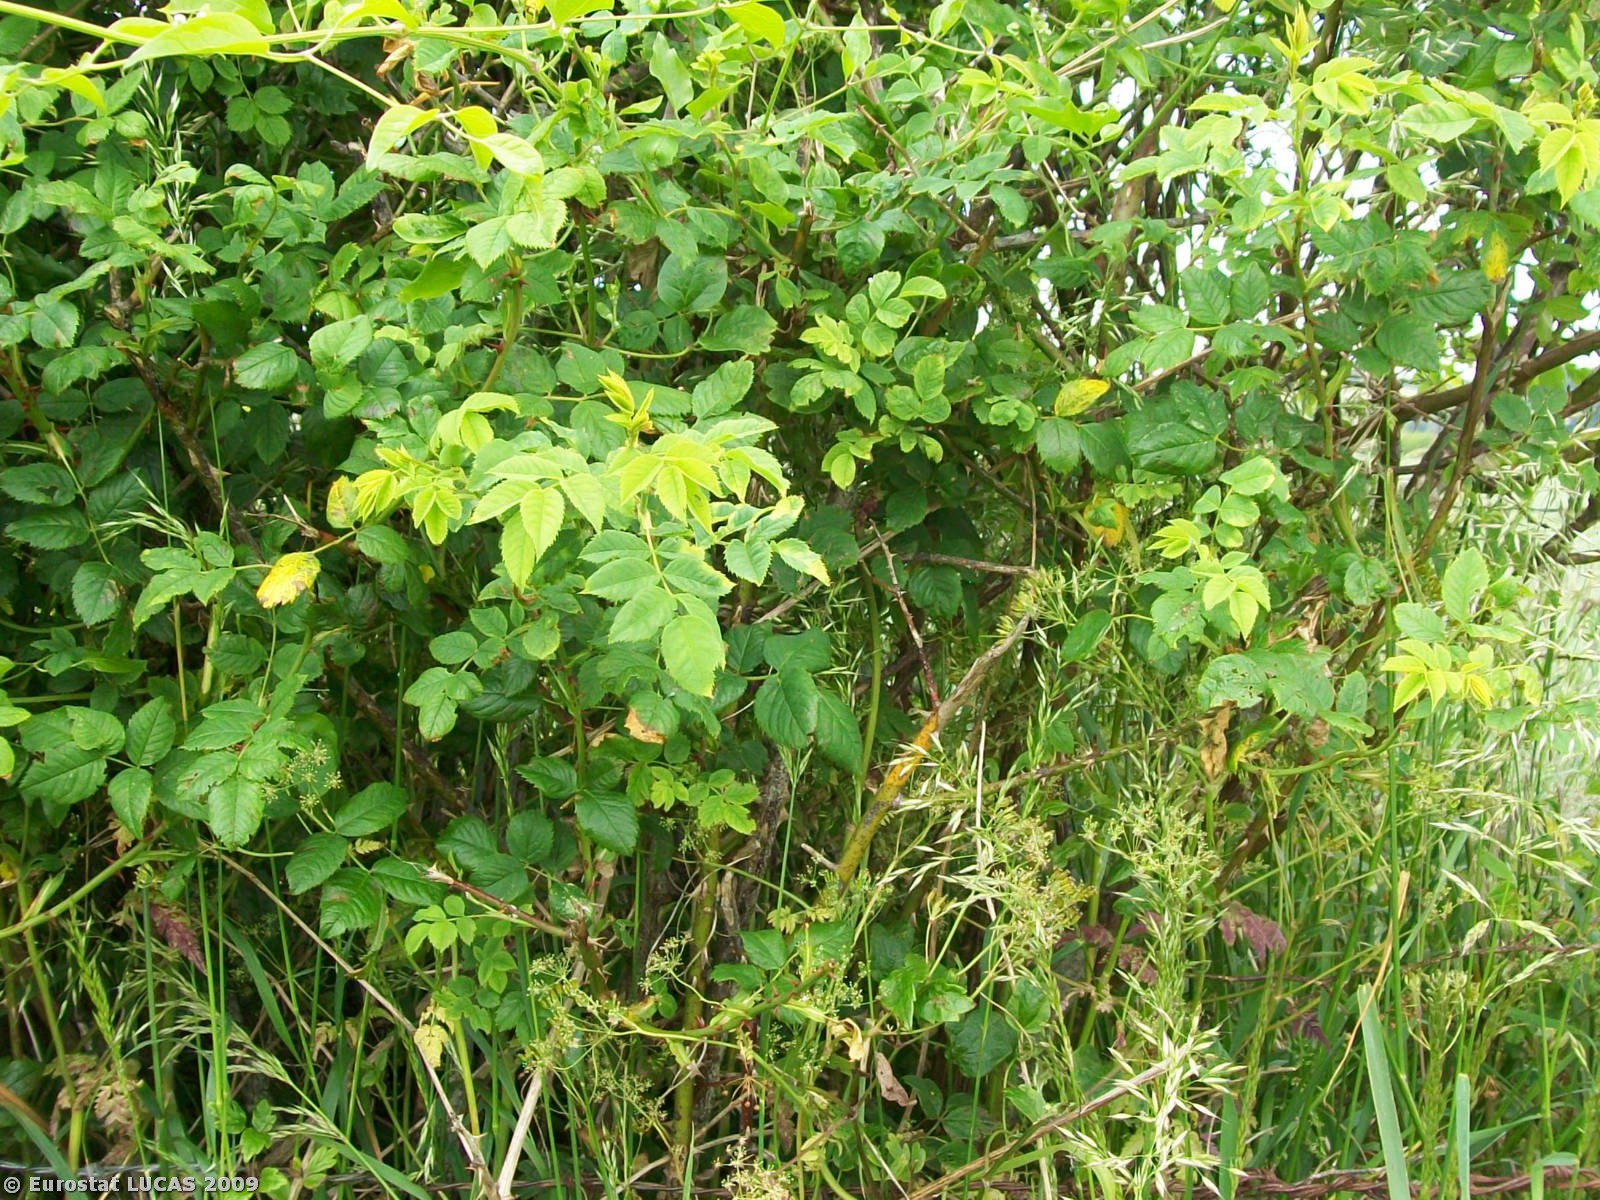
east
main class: Cropland
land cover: Barley
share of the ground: > 75 %
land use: Agriculture (excluding fallow land and kitchen gardens)
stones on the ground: 10 - 25 %
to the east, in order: Barley; Grass margins; Managed hedges; Grass margins; Common wheat
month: June
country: GB
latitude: 50.8652
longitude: -2.0943
